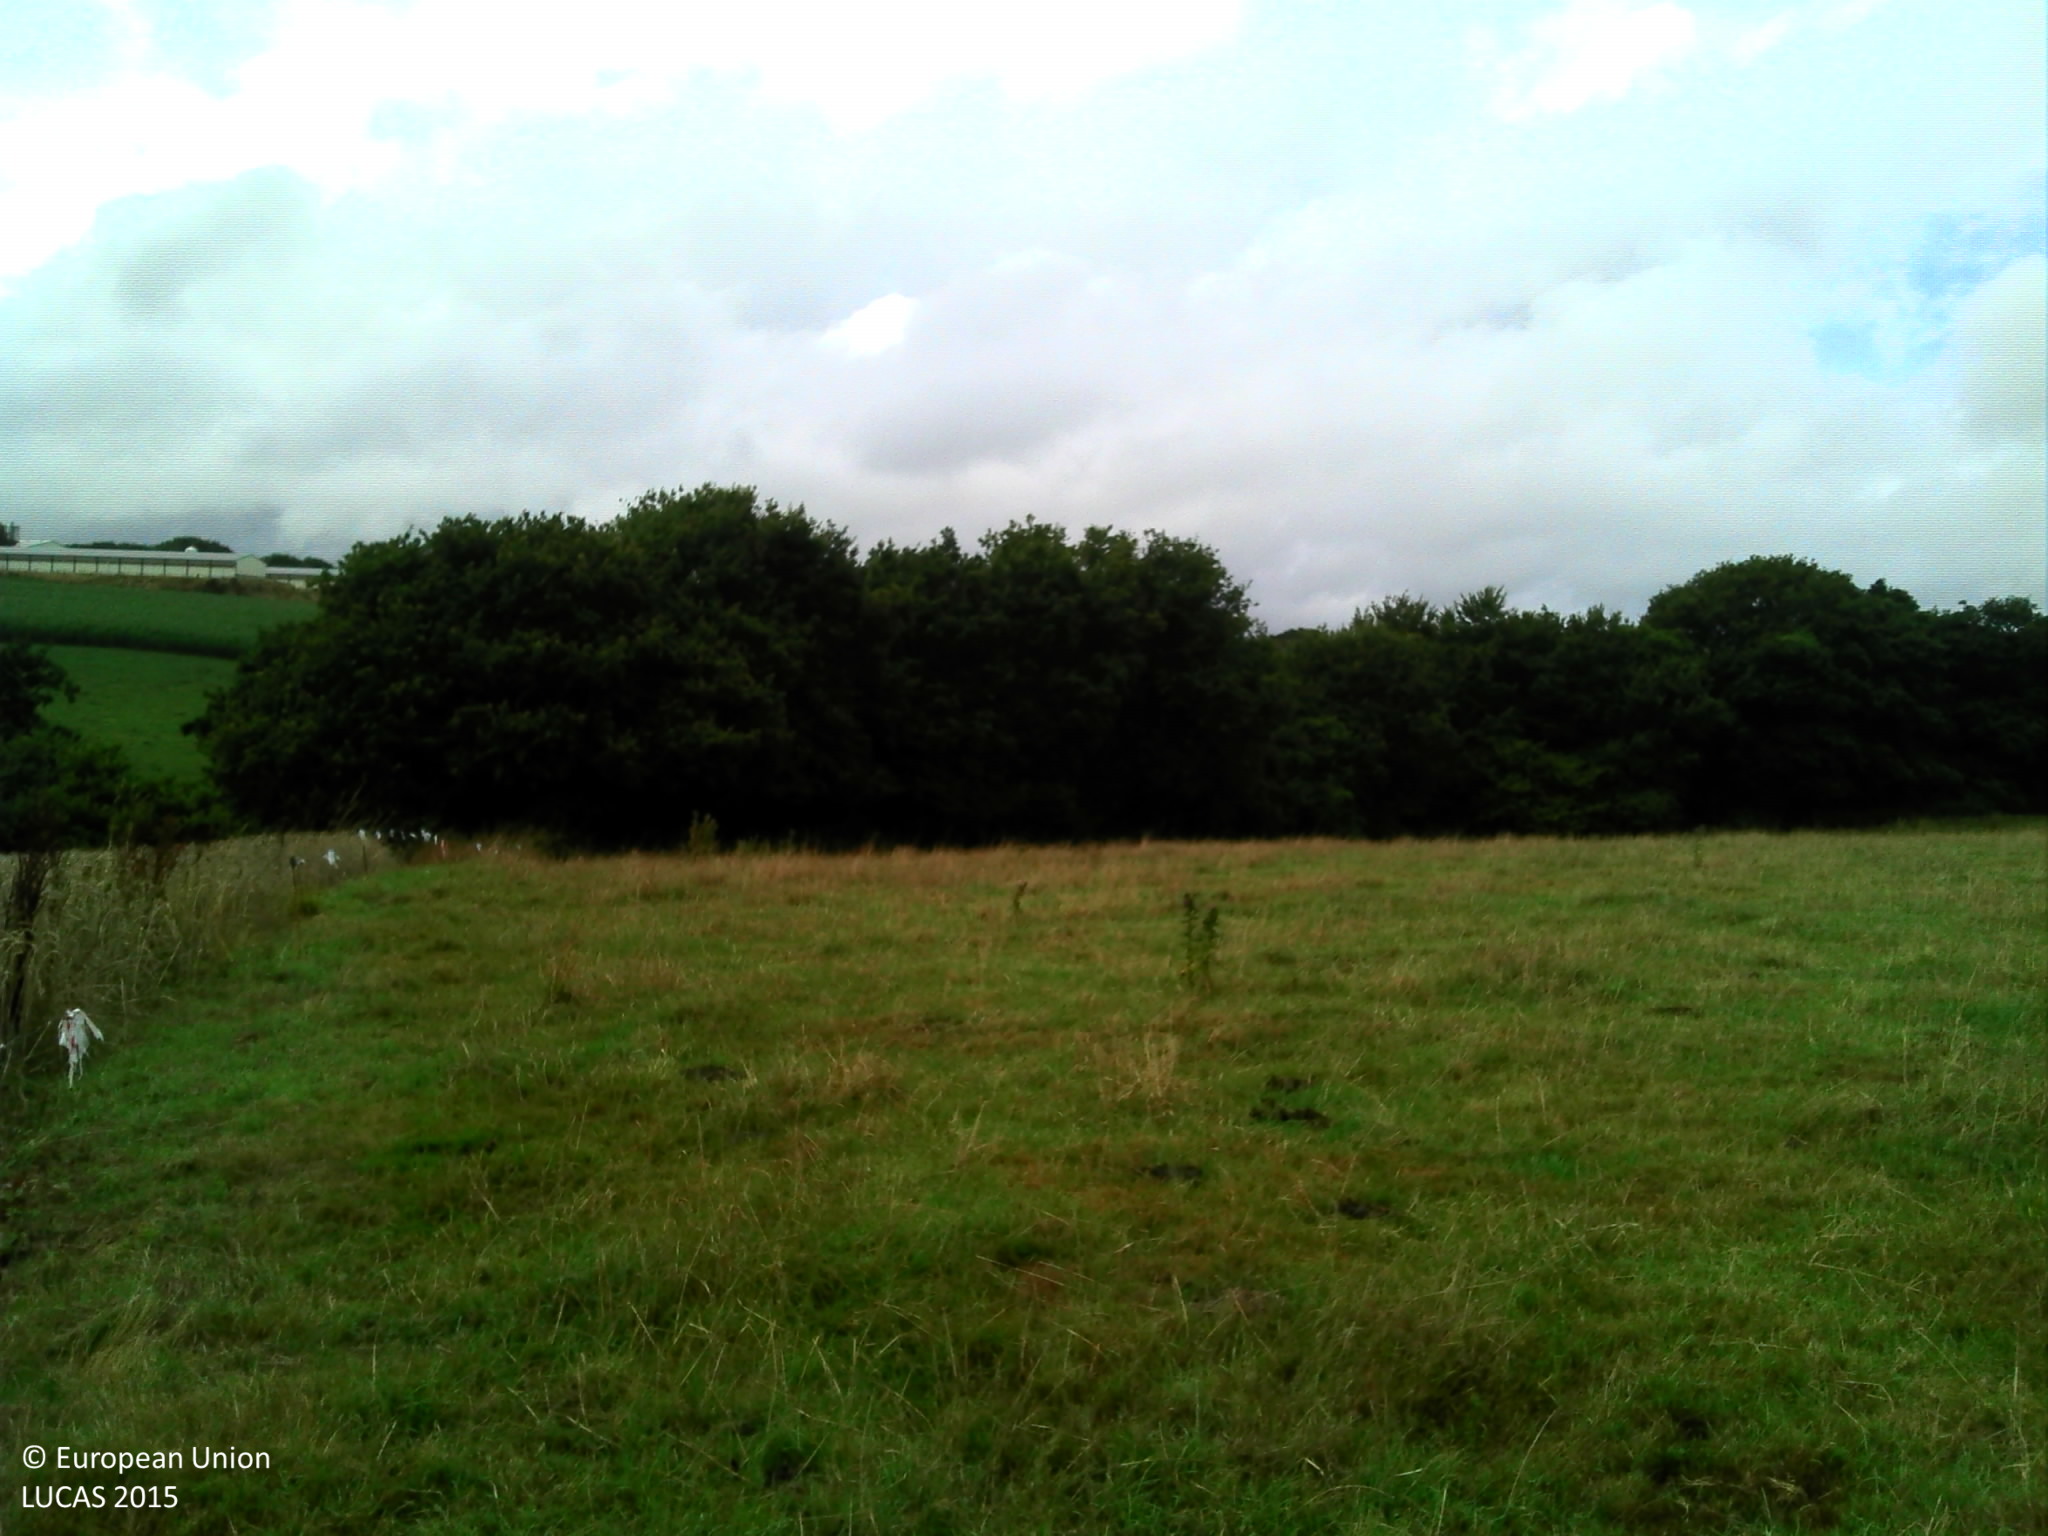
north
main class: Grassland
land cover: Grassland without tree/shrub cover
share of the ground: > 75 %
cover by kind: herbaceous plants 100 %
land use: Agriculture (excluding fallow land and kitchen gardens)
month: August
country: FR
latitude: 48.3789
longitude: -3.1552
